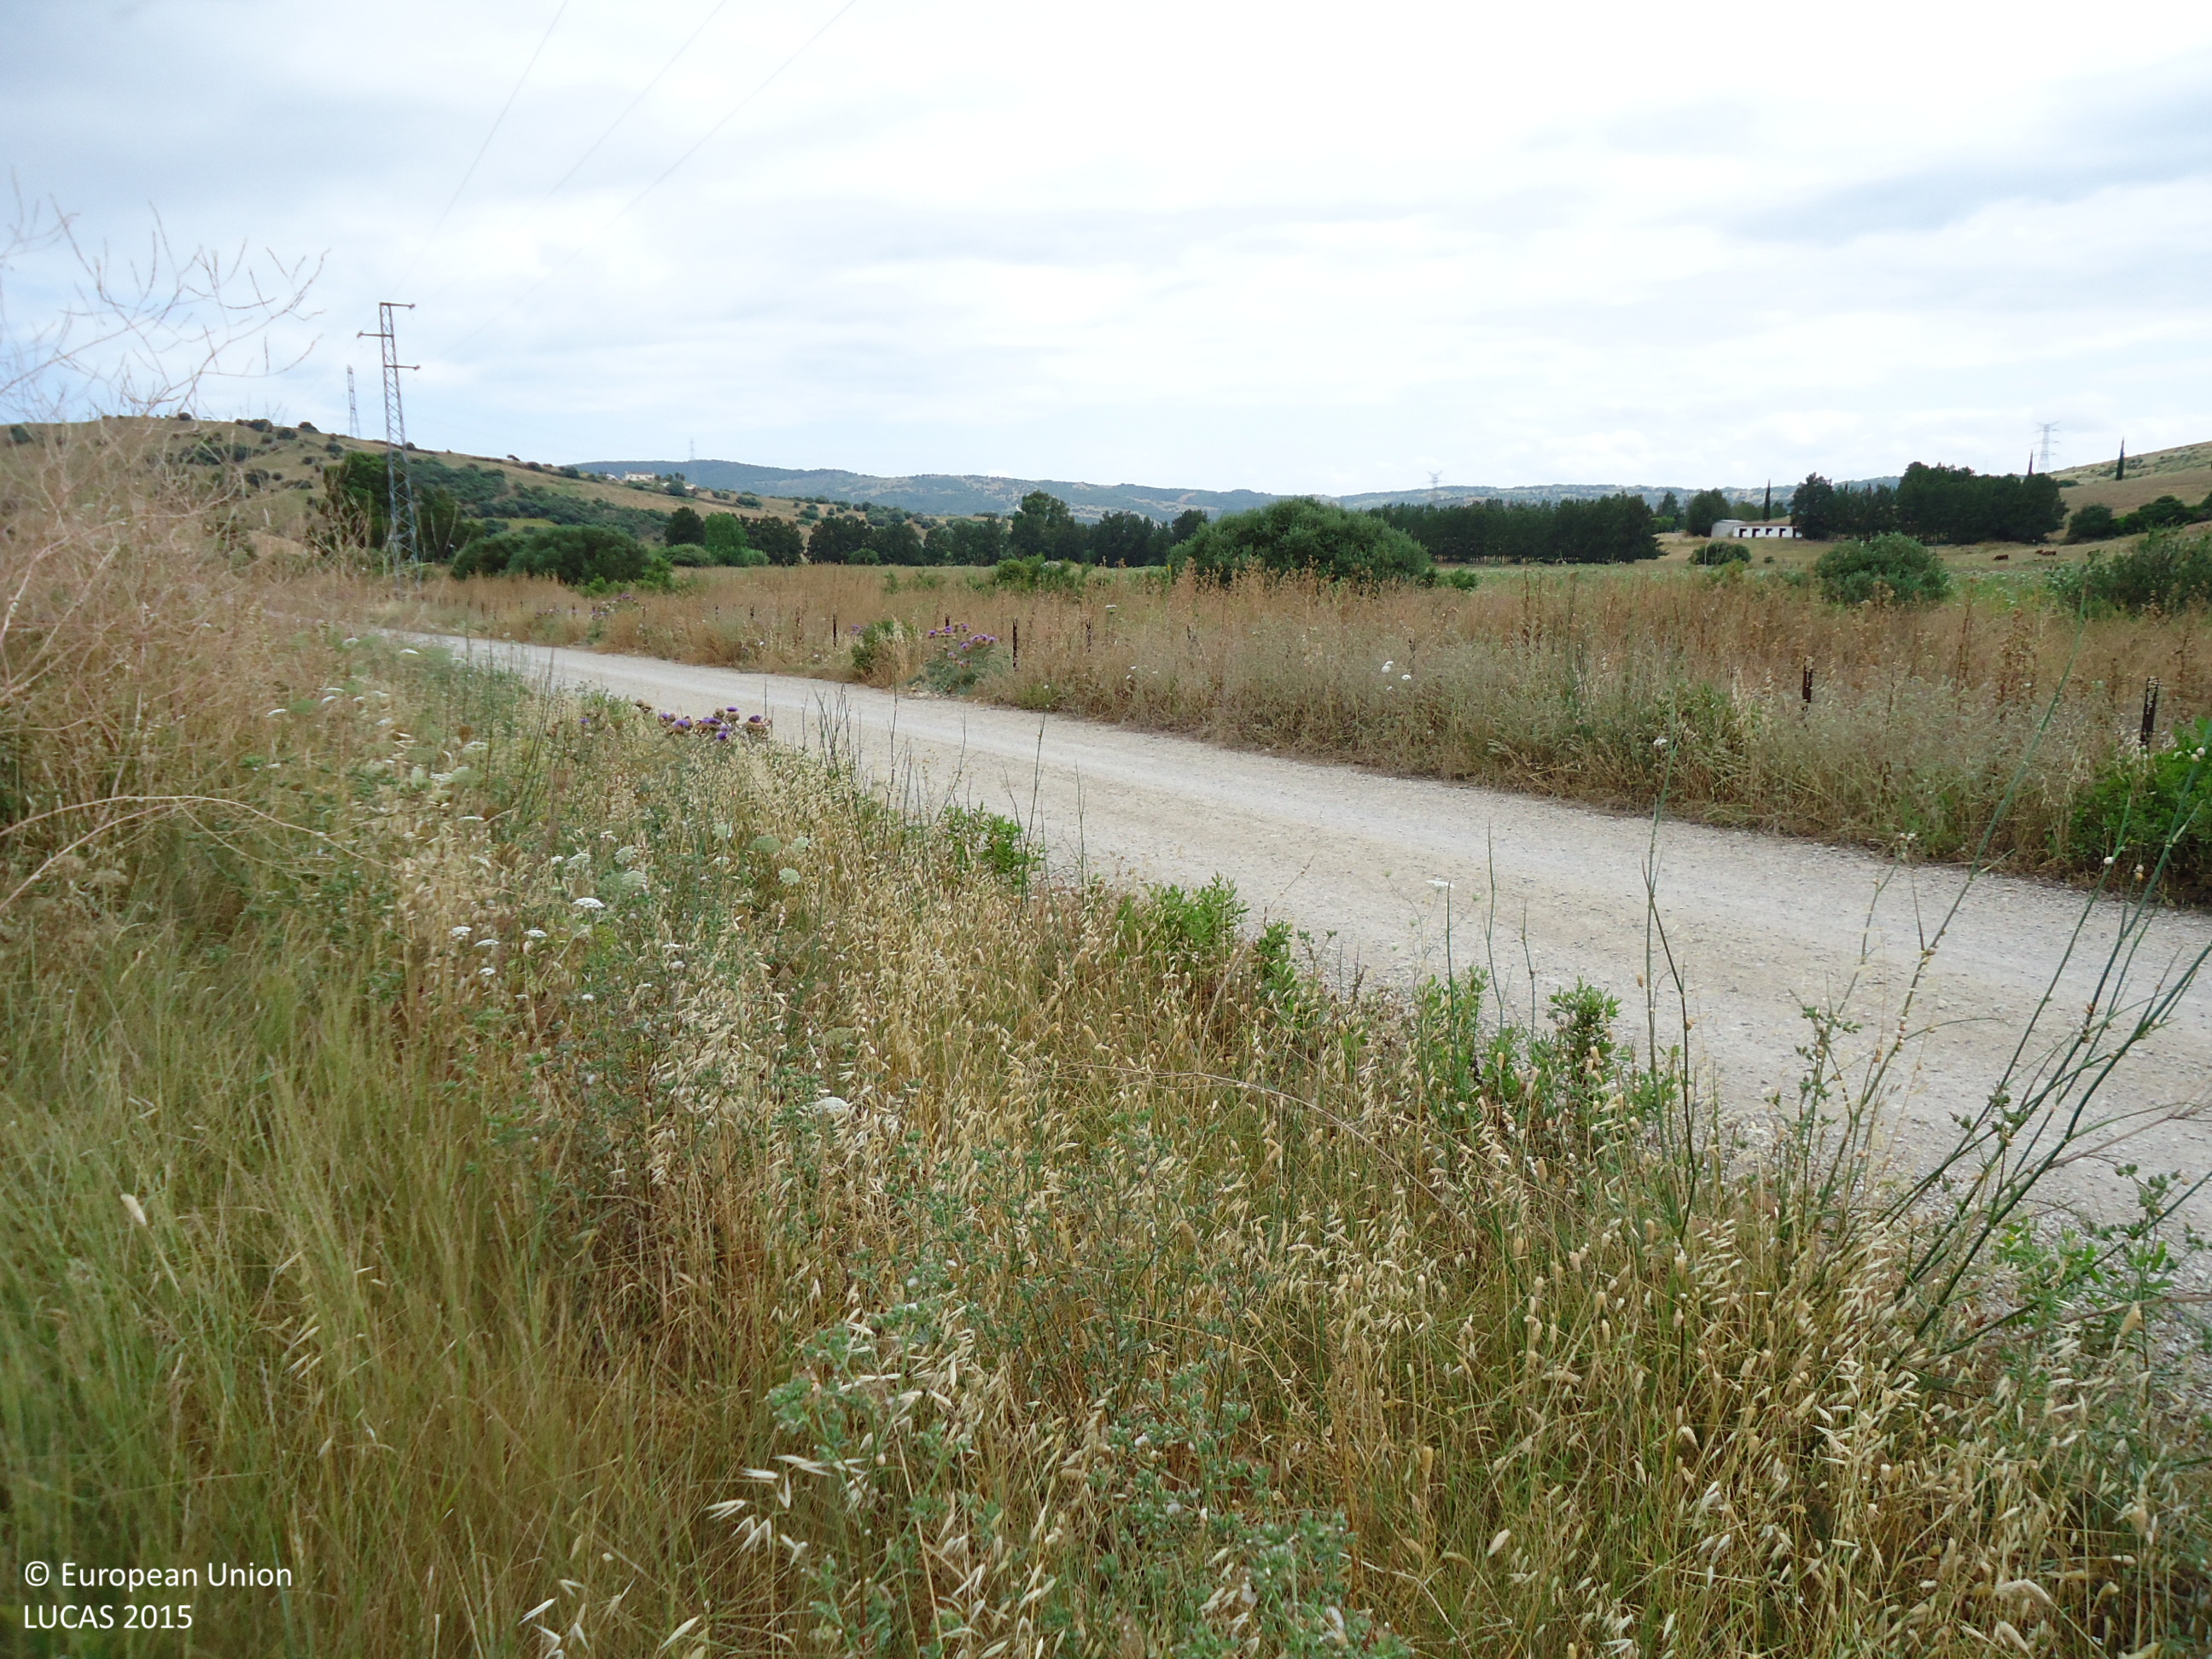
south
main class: Grassland
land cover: Spontaneously vegetated surfaces
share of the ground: > 75 %
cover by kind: herbaceous plants 100 %
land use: Agriculture (excluding fallow land and kitchen gardens)
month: June
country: ES
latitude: 36.3443
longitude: -5.3591
